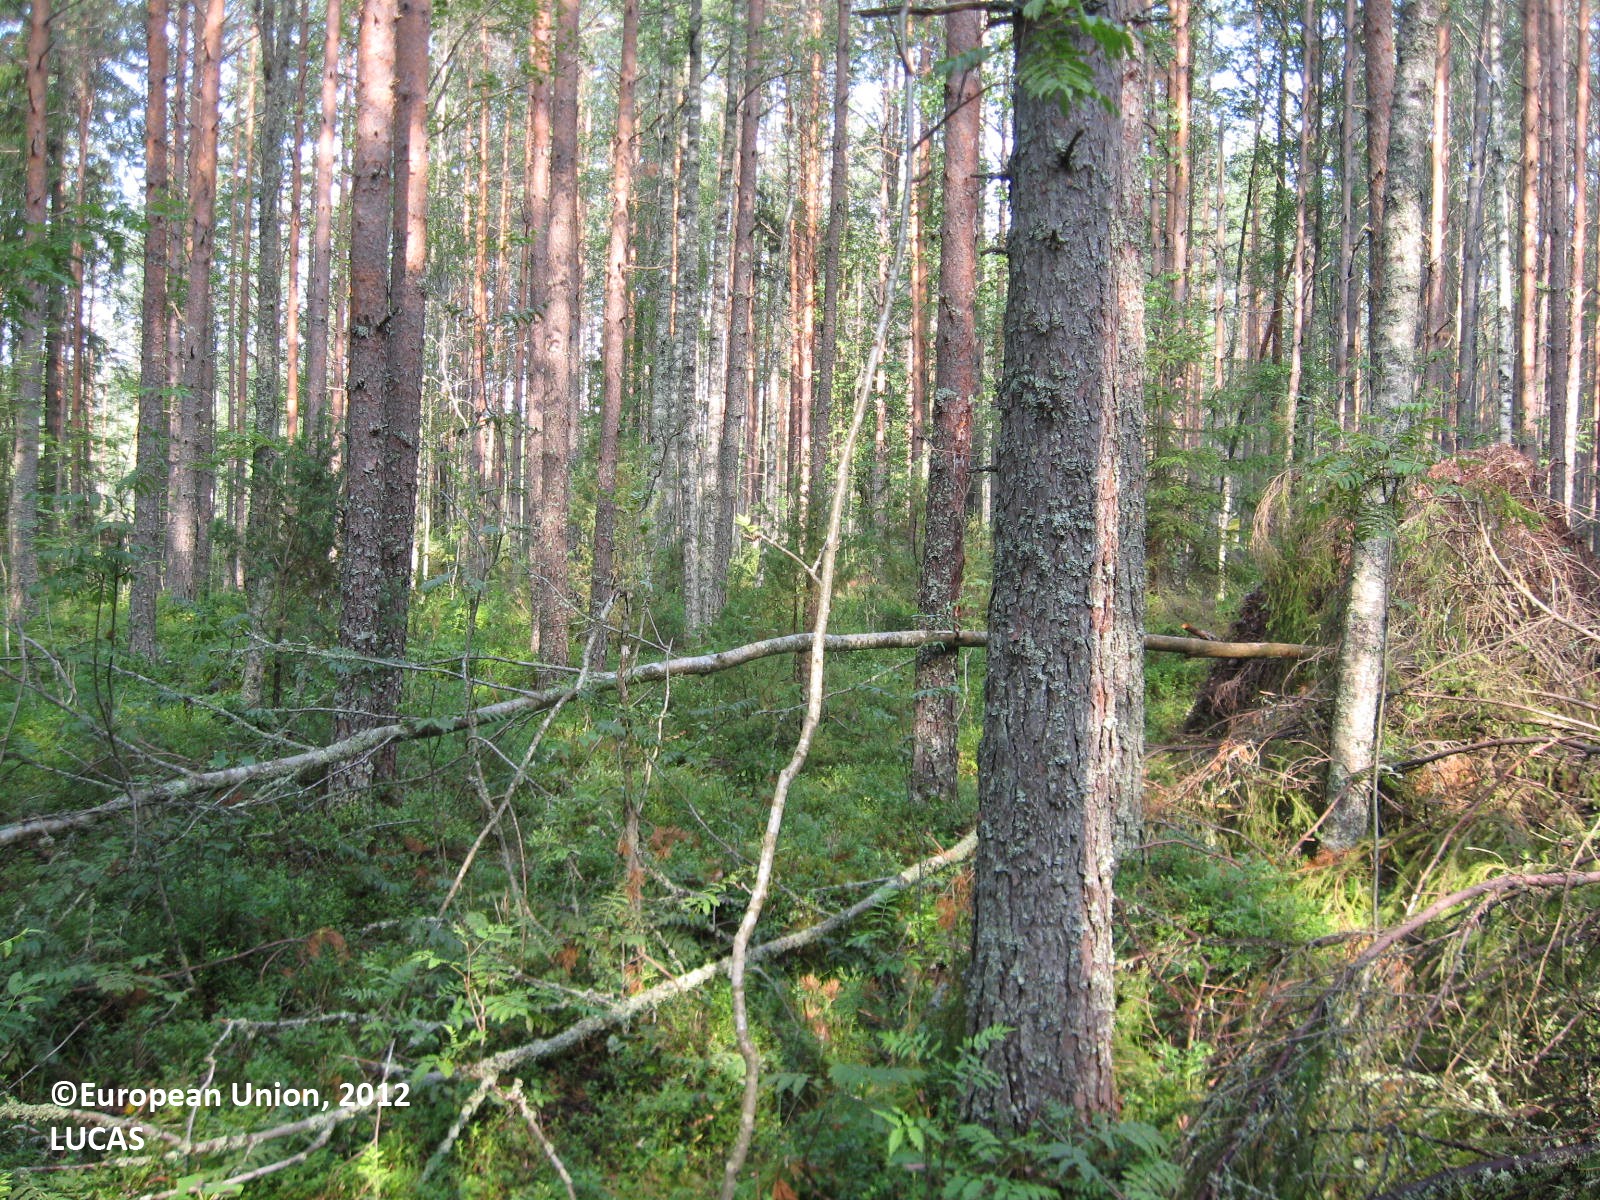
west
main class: Woodland
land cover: Pine dominated mixed woodland
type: boreal forest
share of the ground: > 75 %
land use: Forestry
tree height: > 5 m
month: July
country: FI
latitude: 61.8936
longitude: 22.2151
